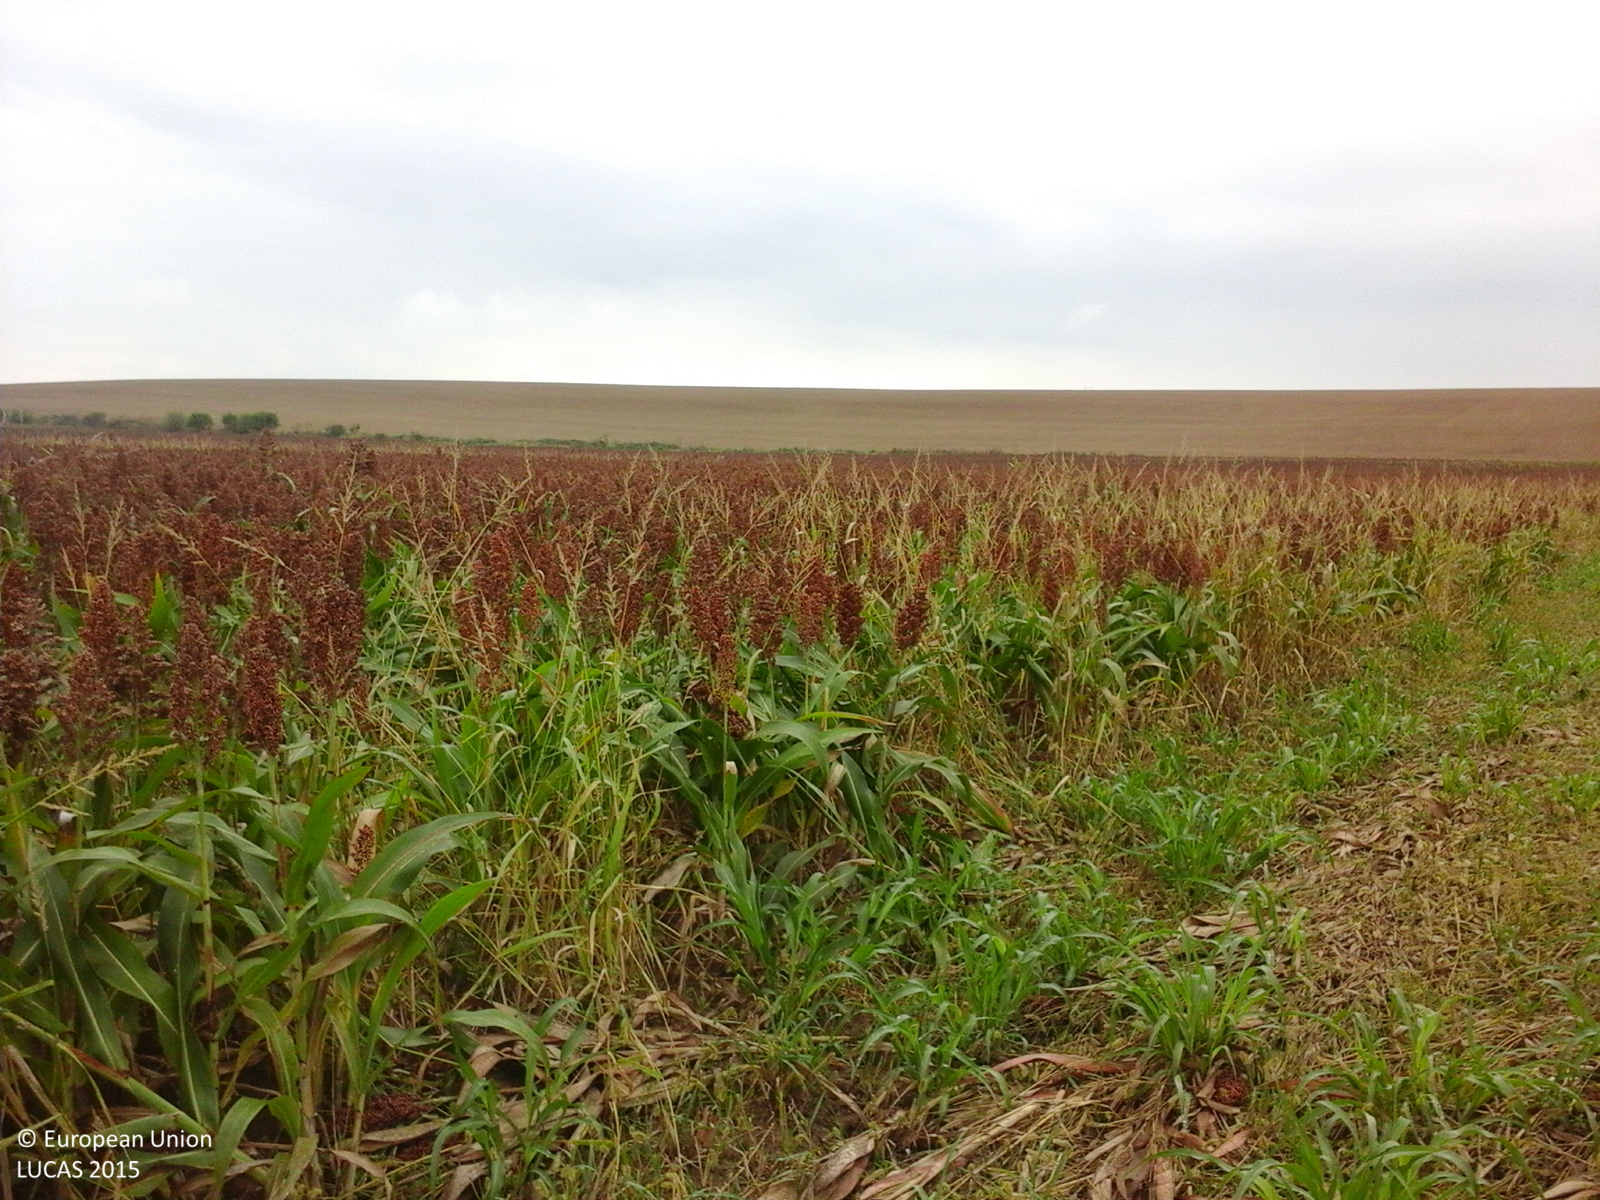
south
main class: Cropland
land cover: Other cereals
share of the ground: > 75 %
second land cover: Spontaneously vegetated surfaces
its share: 25 - 50 %
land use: Agriculture (excluding fallow land and kitchen gardens)
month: September
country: RO
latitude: 45.5942
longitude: 22.0512
